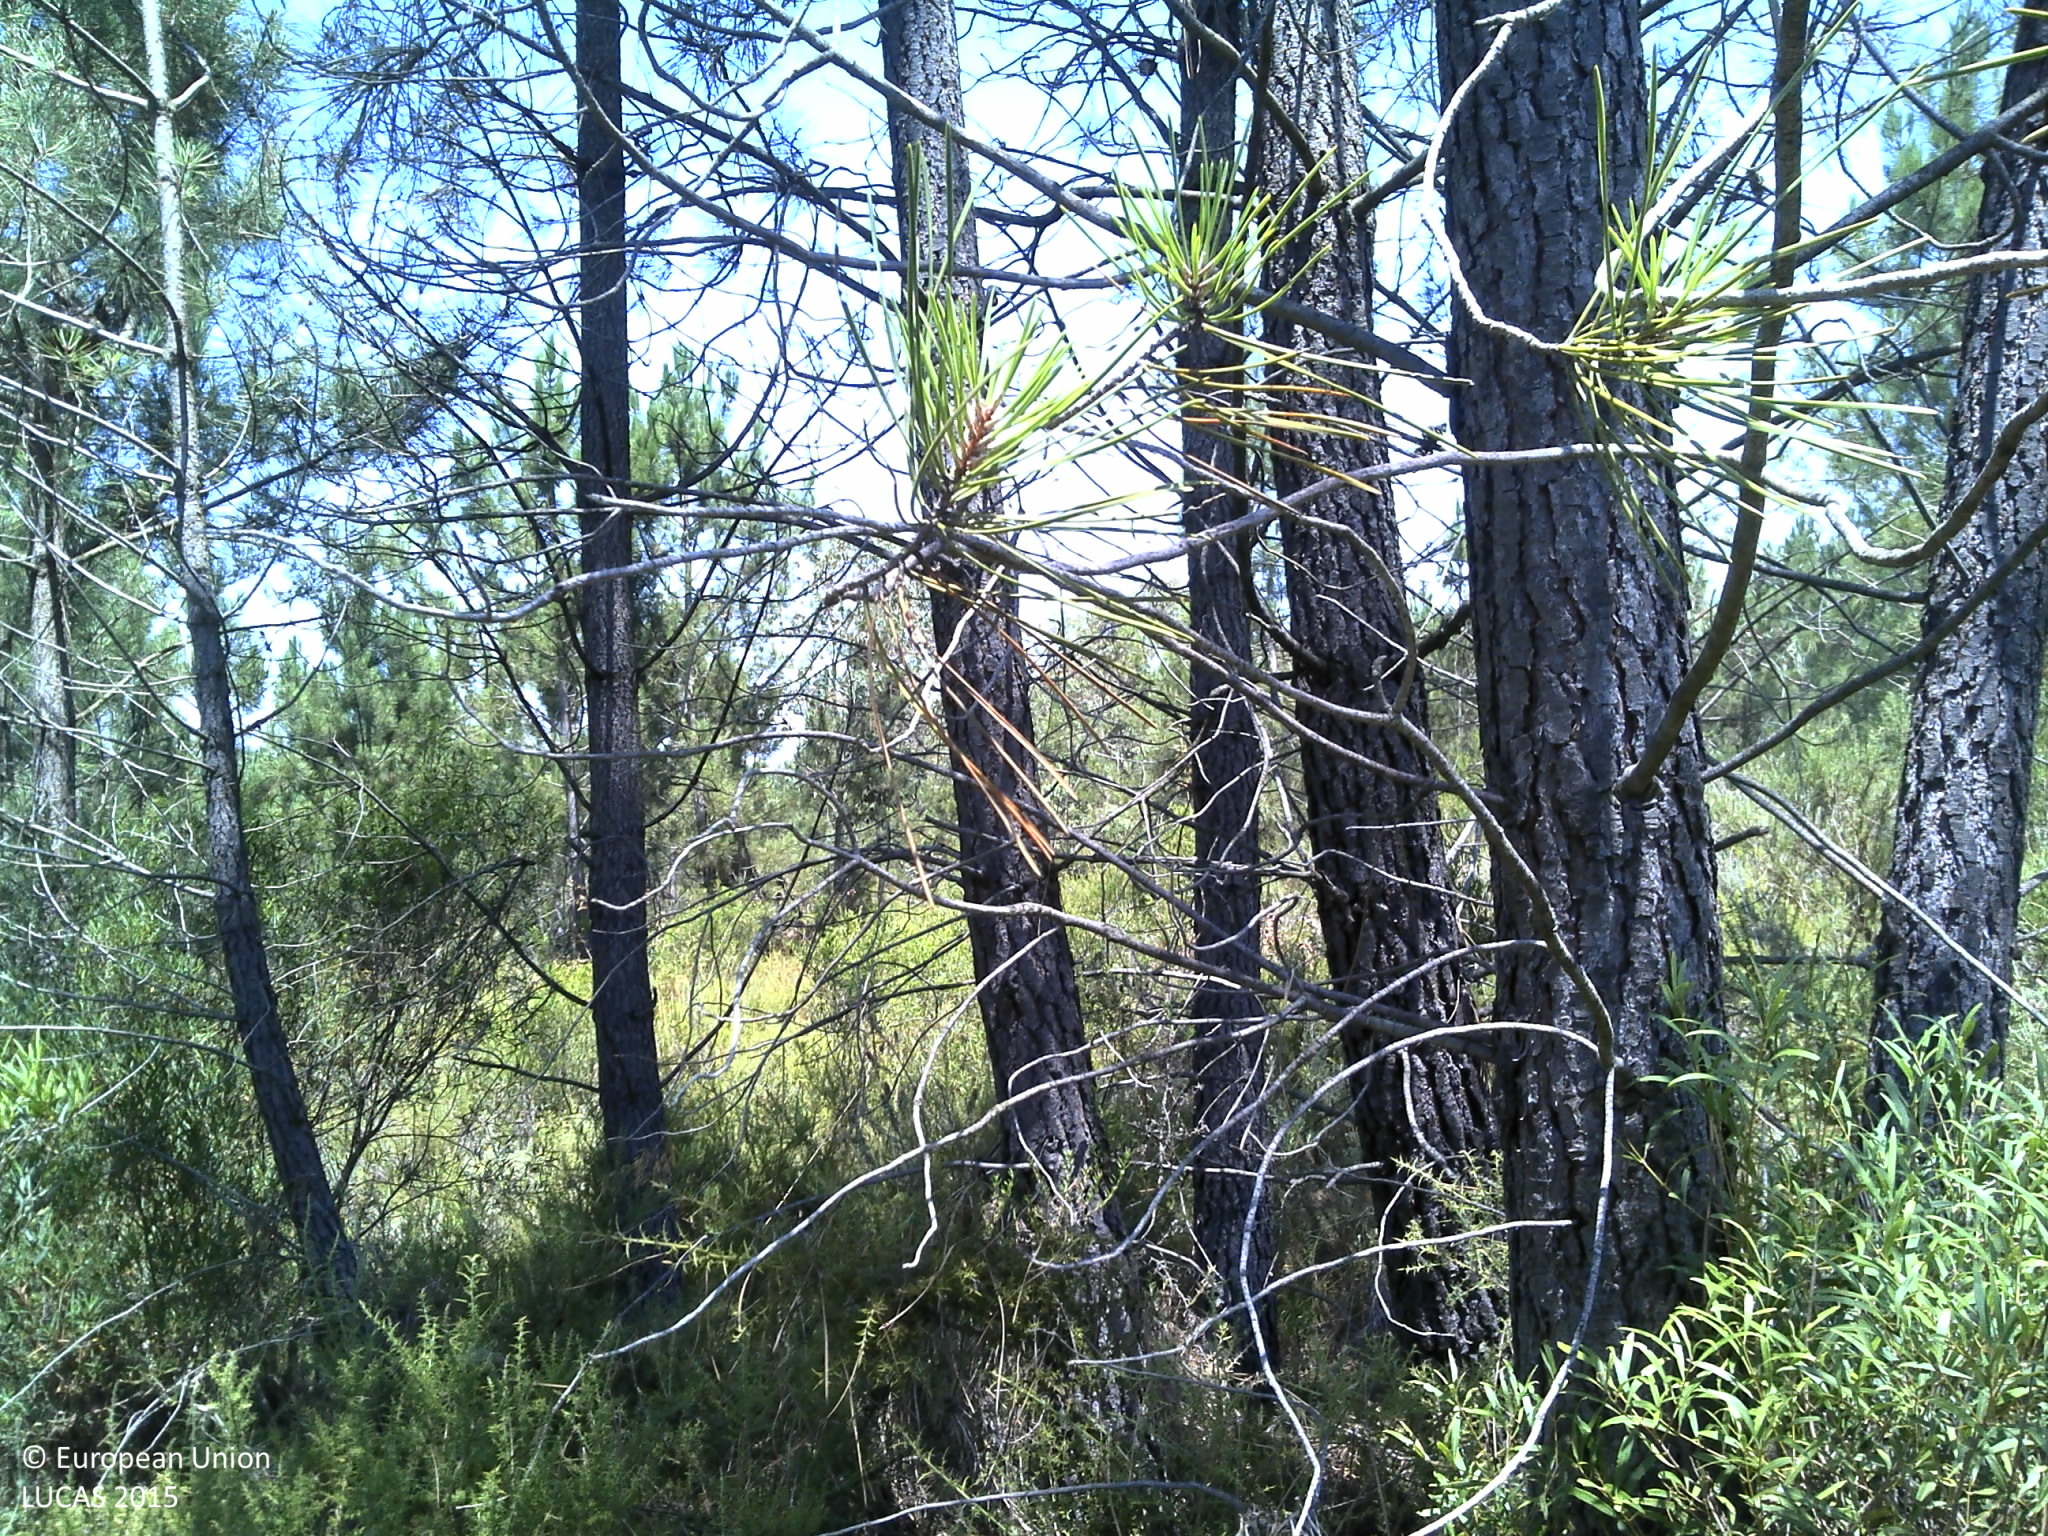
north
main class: Woodland
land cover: Pine dominated coniferous woodland
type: coniferous forest of the mediterranean region
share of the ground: 25 - 50 %
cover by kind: coniferous forest trees 40 %, shrubs 30 %, unconsolidated bare surface 25 %, herbaceous plants 5 %
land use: Forestry
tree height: > 5 m
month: June
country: PT
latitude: 38.6027
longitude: -9.1457
